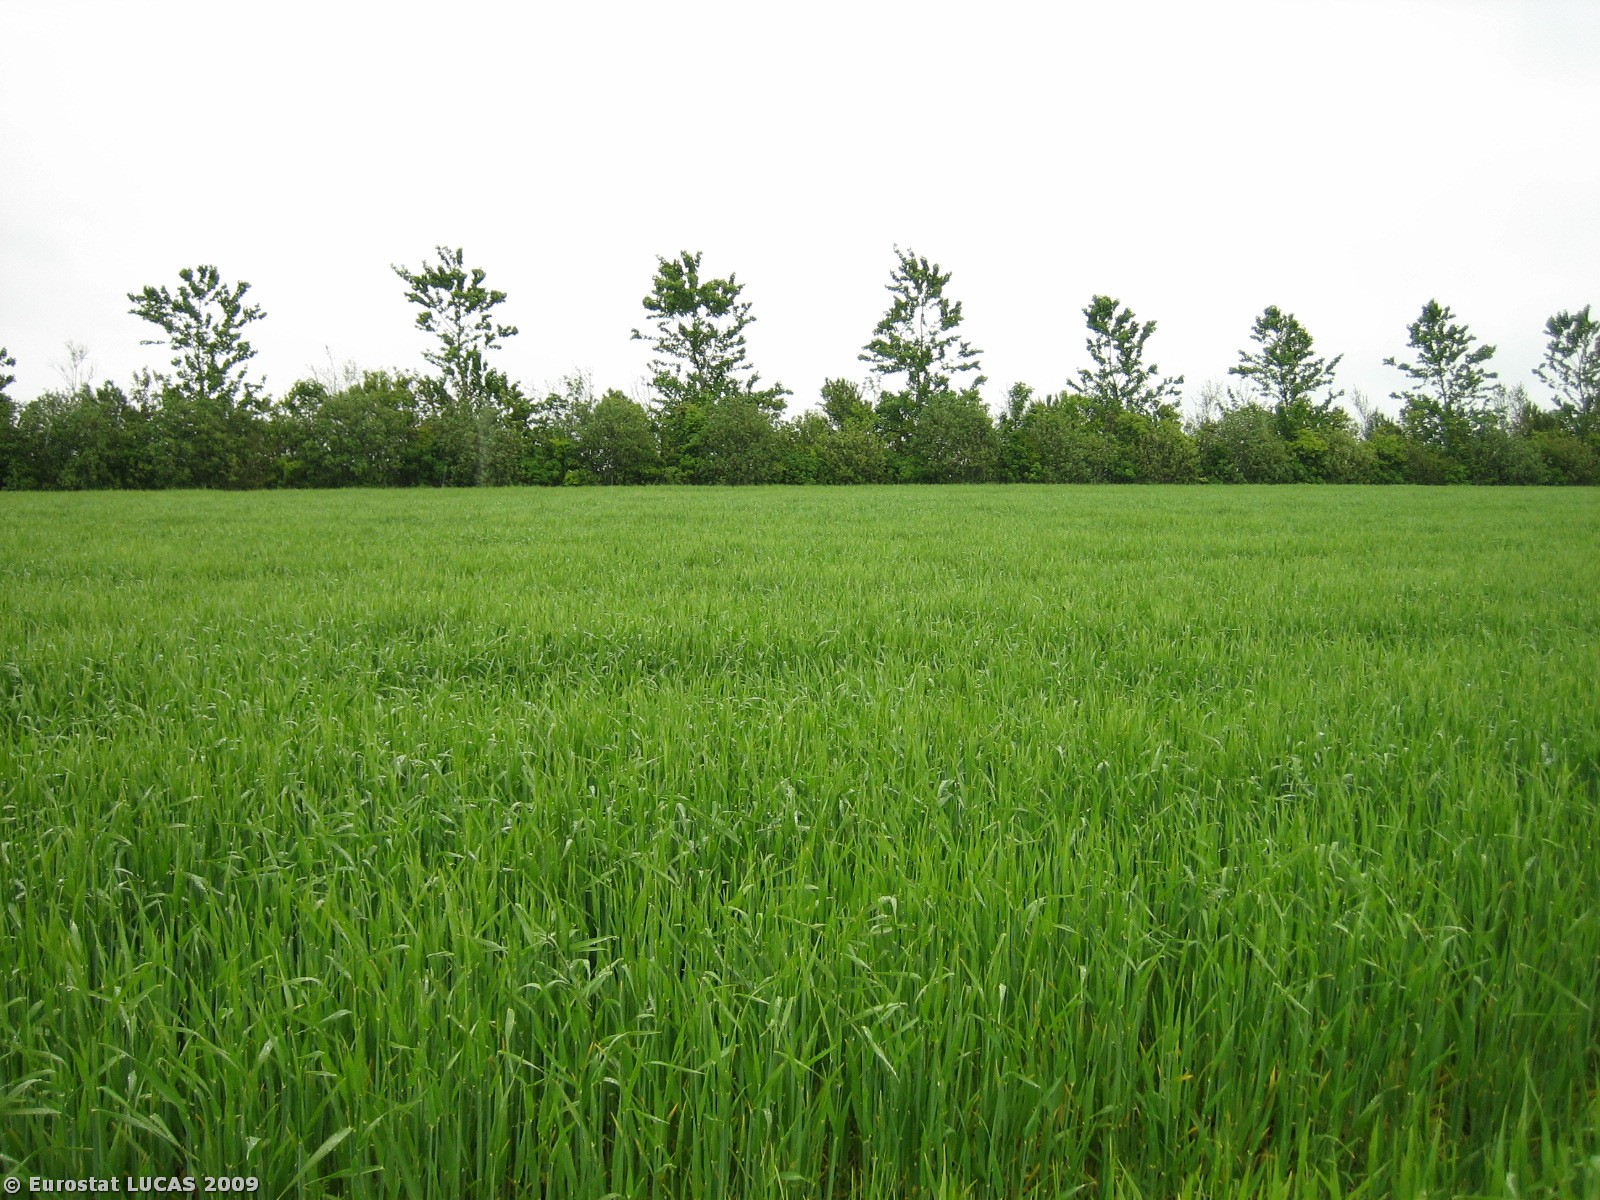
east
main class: Cropland
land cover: Barley
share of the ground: > 75 %
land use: Agriculture (excluding fallow land and kitchen gardens)
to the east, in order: Barley; Shrubland with sparse tree cover; Maize; Grass margins; Tracks; Grass margins; Maize
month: May
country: DK
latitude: 56.0532
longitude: 8.5083
